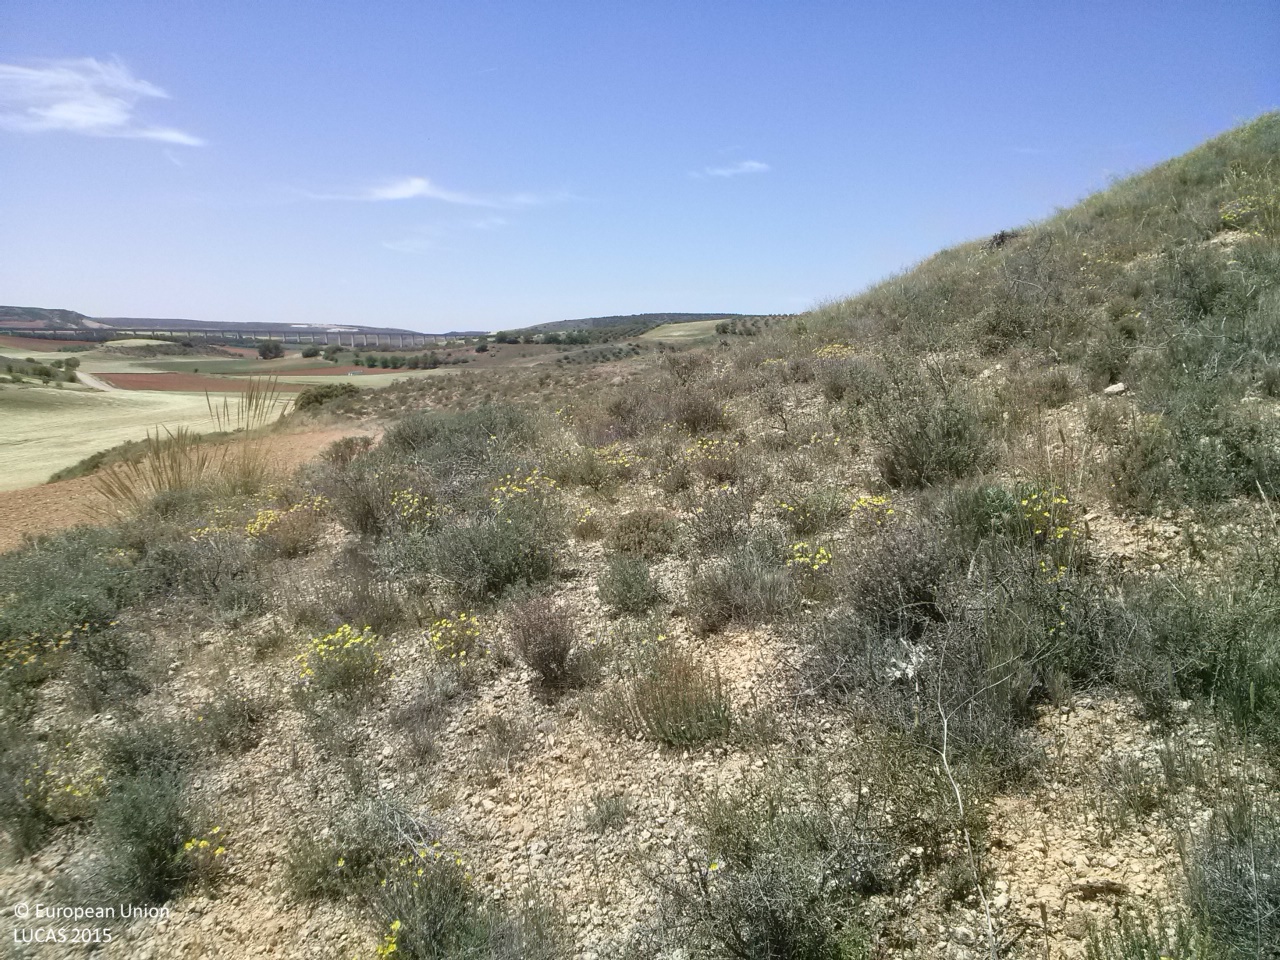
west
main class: Shrubland
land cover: Shrubland without tree cover
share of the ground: 50 - 75 %
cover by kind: shrubs 40 %, herbaceous plants 30 %, unconsolidated bare surface 30 %
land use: Semi-natural and natural areas not in use
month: May
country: ES
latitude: 40.0845
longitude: -2.7939
